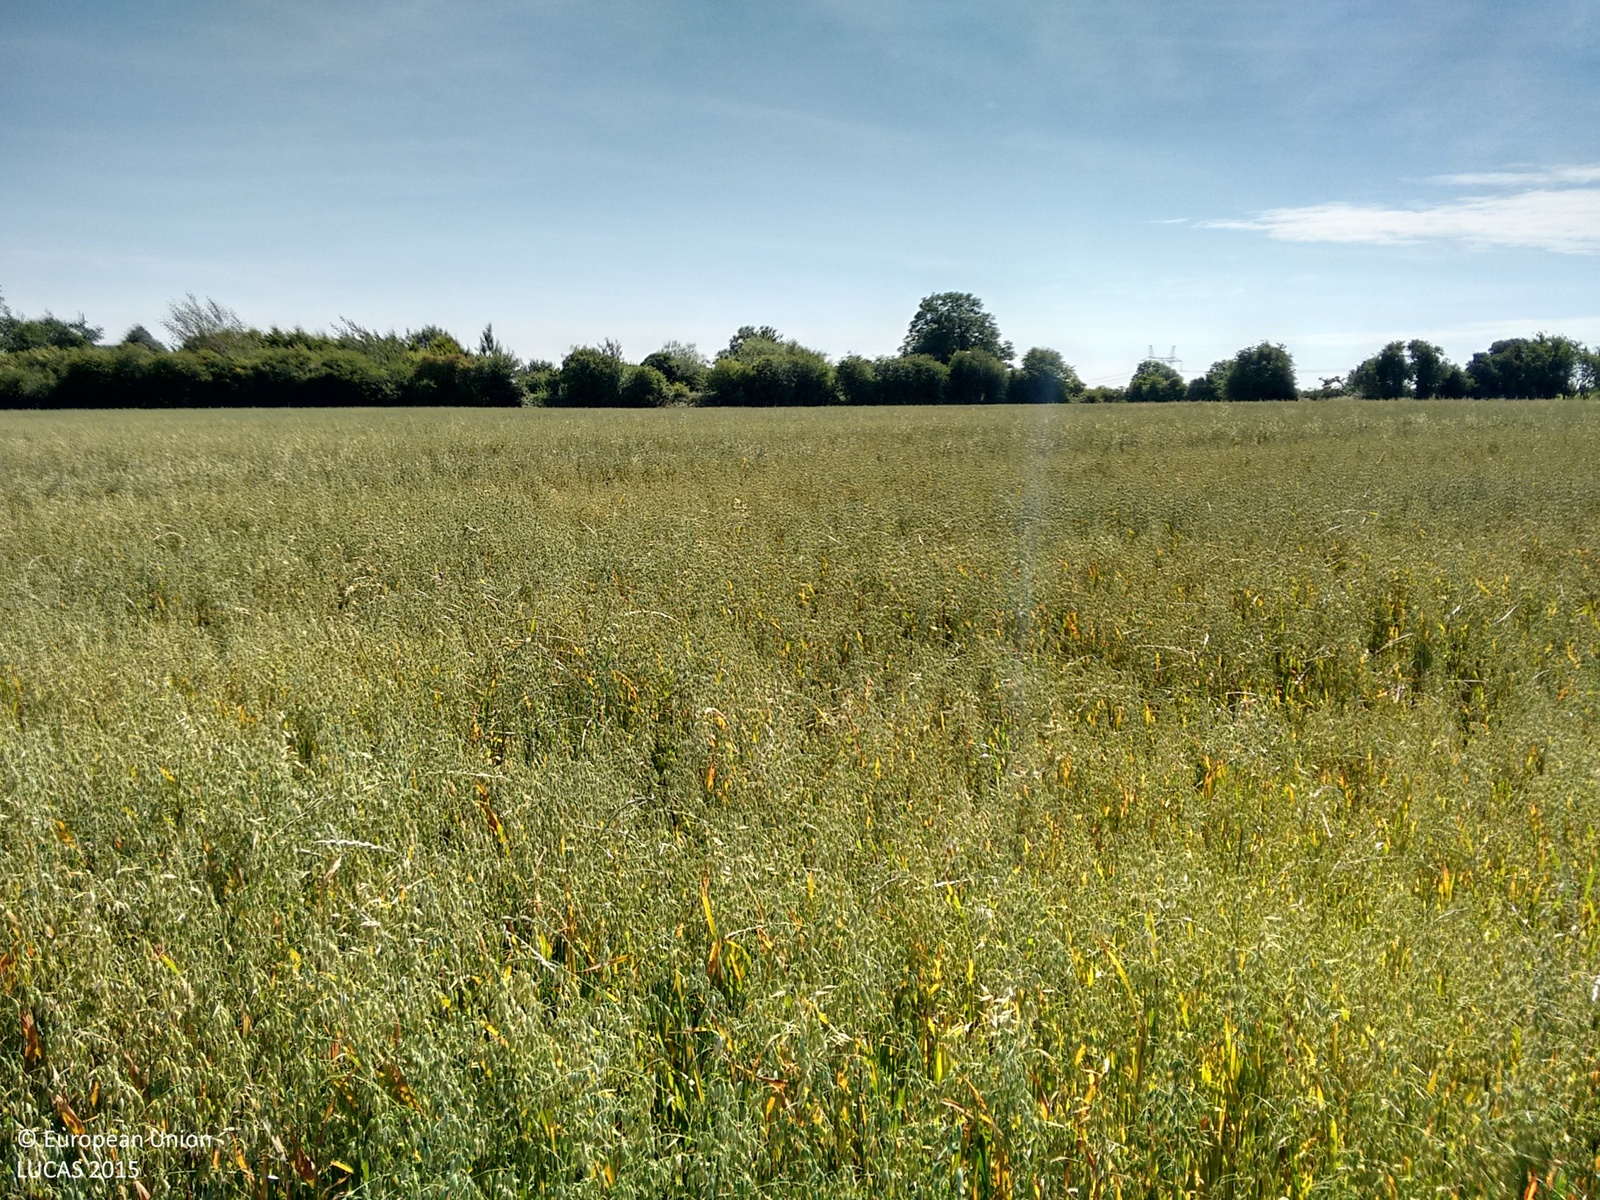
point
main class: Cropland
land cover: Oats
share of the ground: > 75 %
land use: Agriculture (excluding fallow land and kitchen gardens)
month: August
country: IE
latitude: 52.9210
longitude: -7.5165
